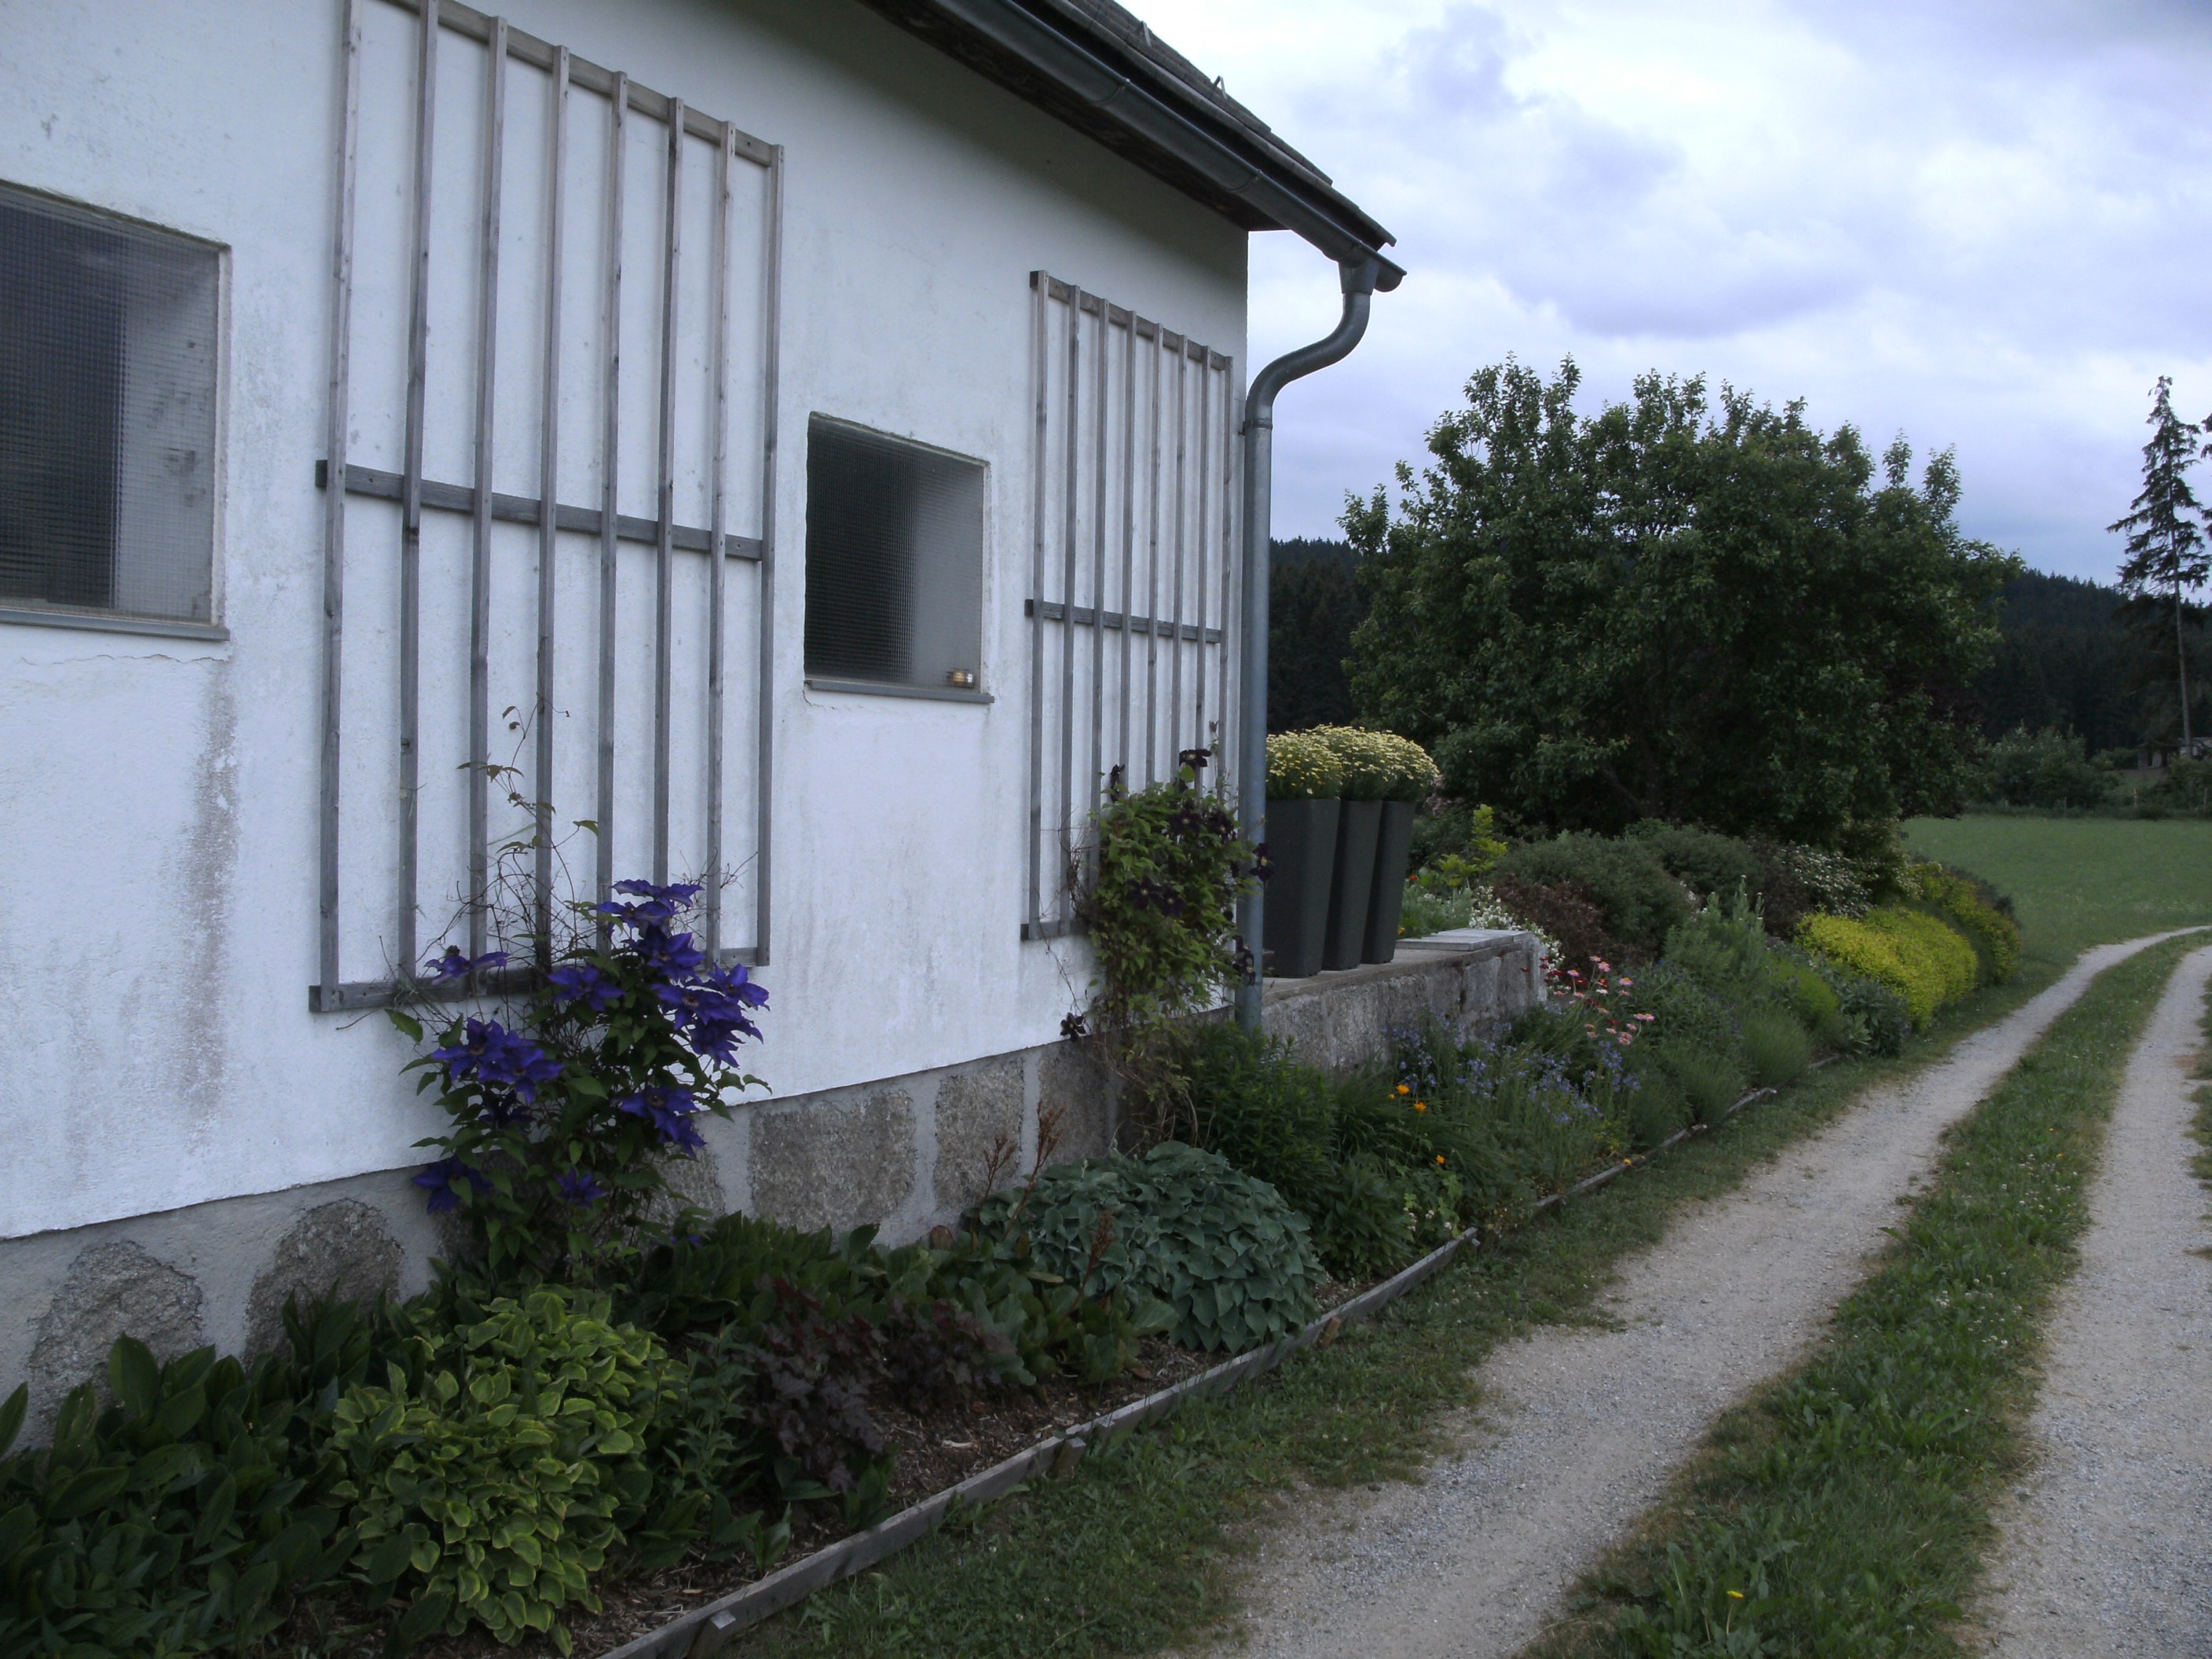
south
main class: Grassland
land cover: Grassland without tree/shrub cover
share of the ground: > 75 %
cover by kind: herbaceous plants 100 %
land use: Agriculture (excluding fallow land and kitchen gardens)
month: June
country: AT
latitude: 48.5585
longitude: 14.1870
